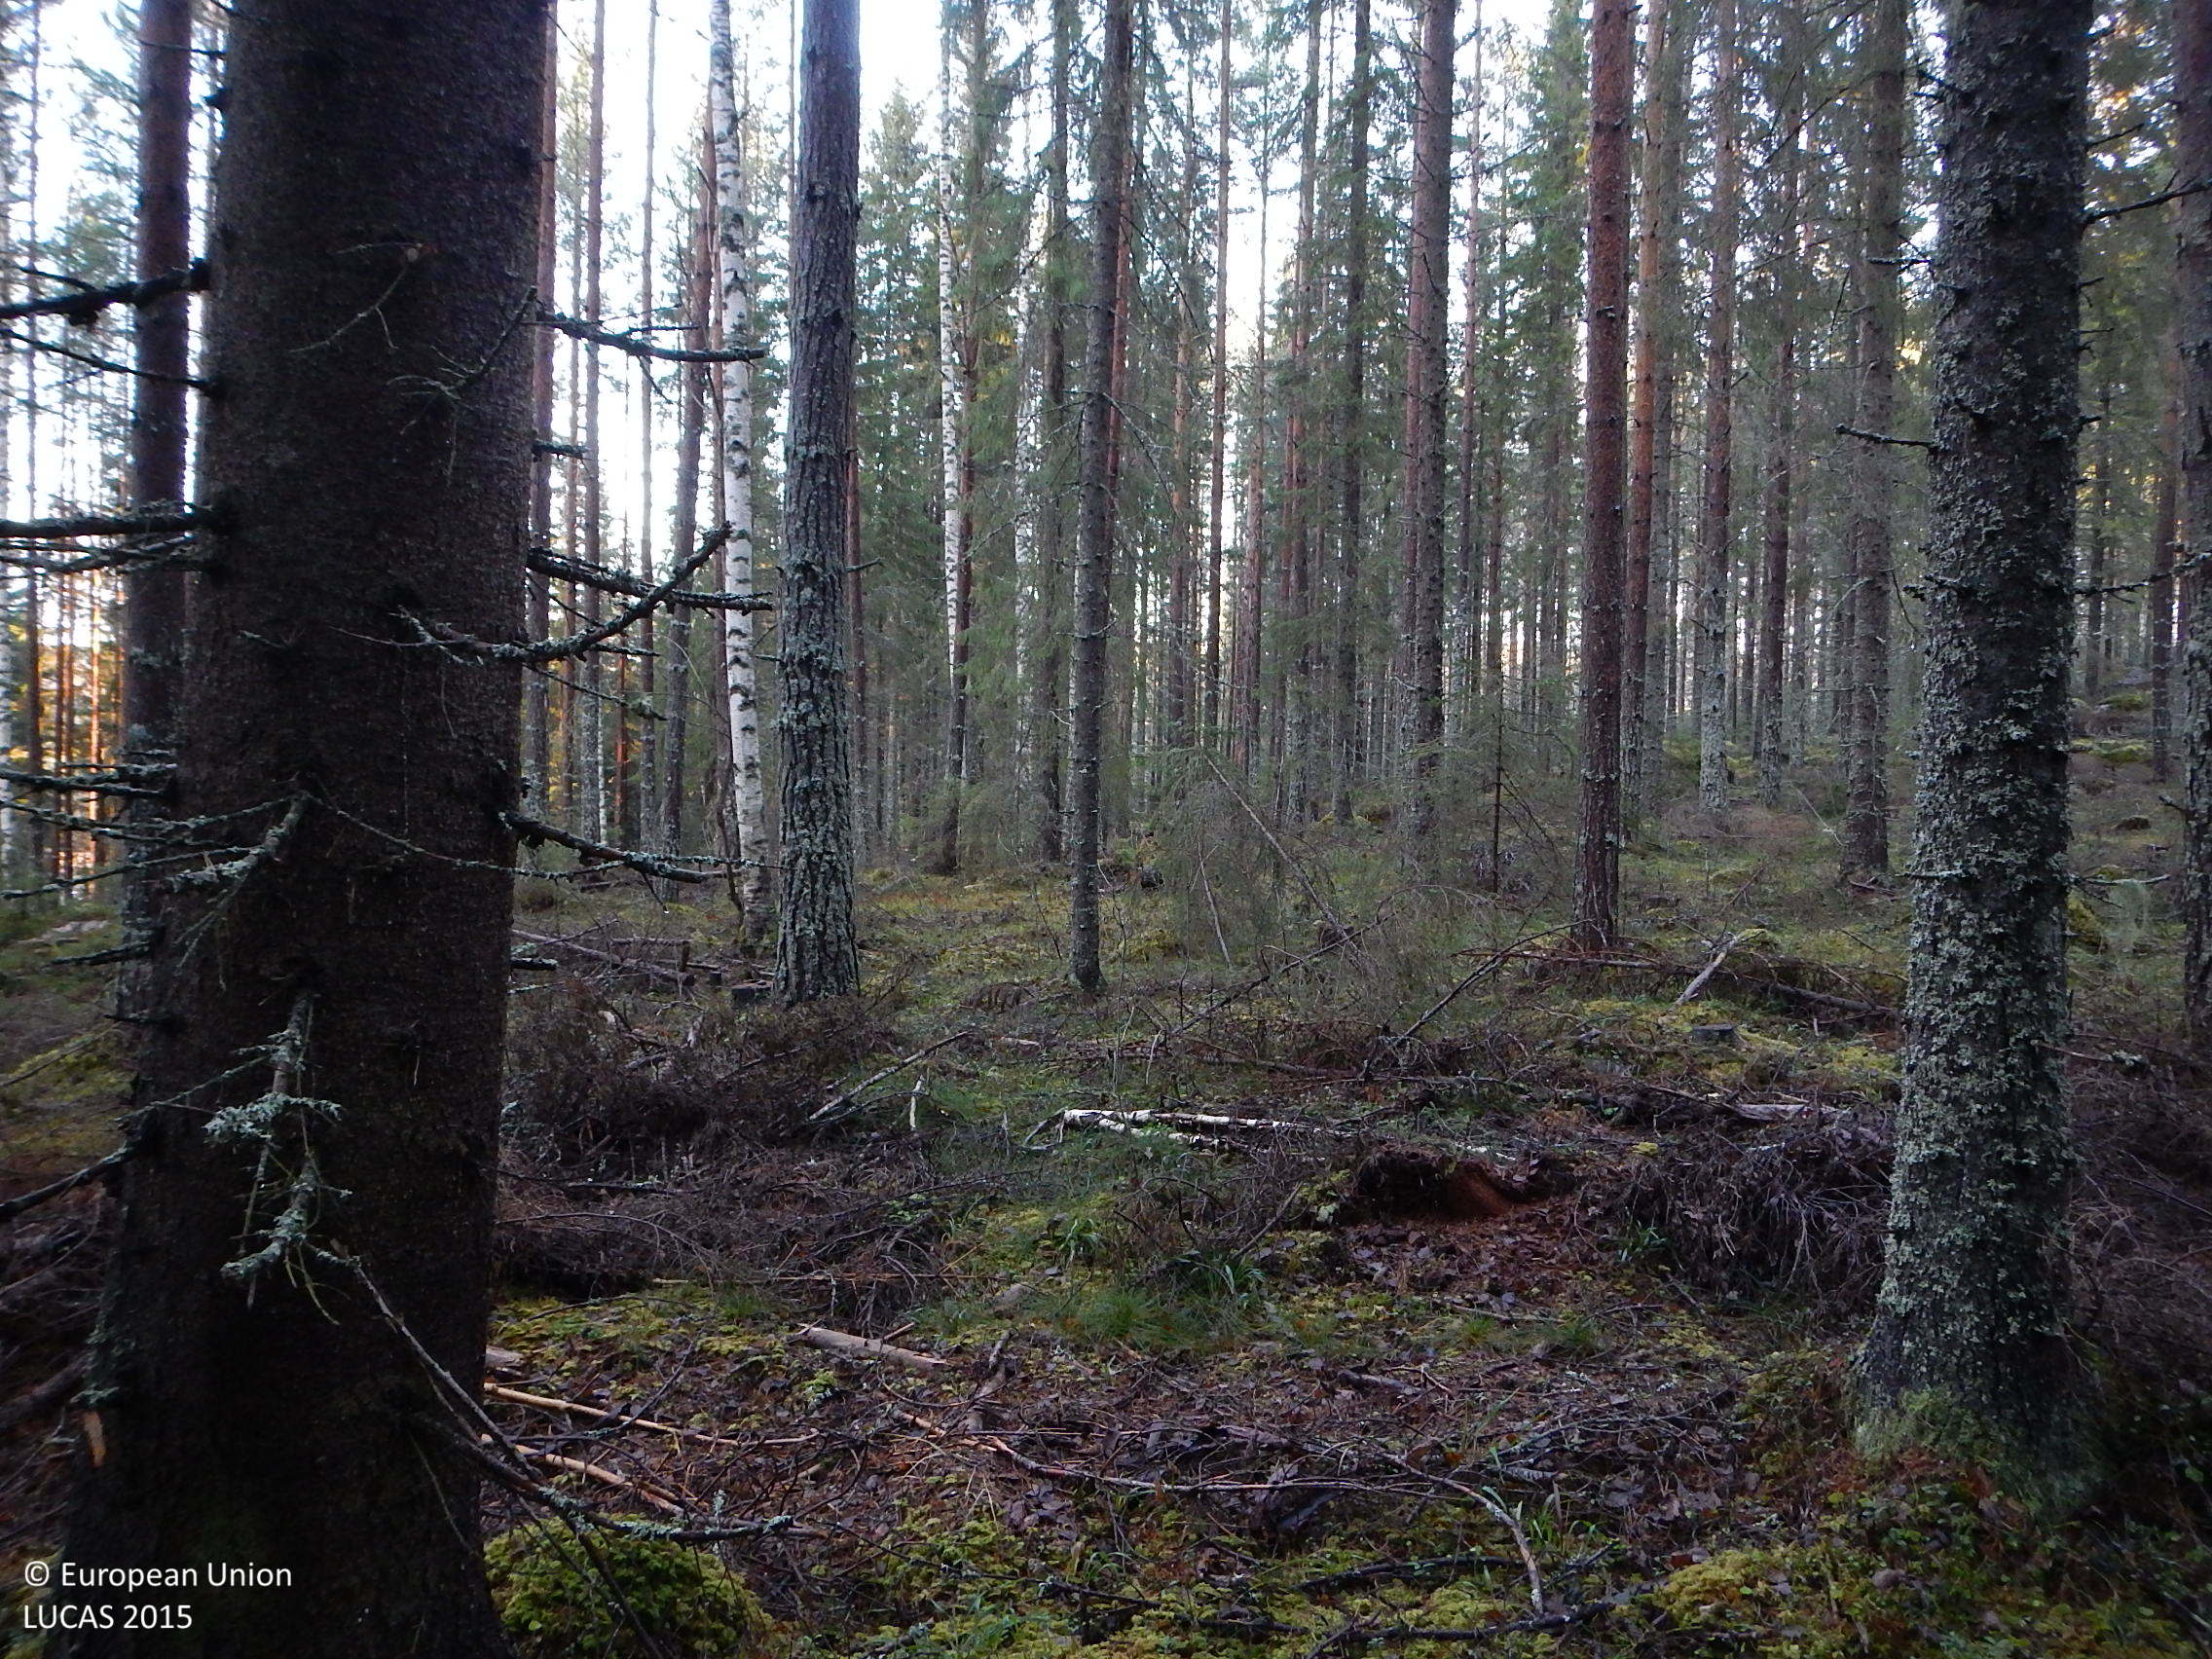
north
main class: Woodland
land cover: Spruce dominated coniferous woodland
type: boreal forest
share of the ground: > 75 %
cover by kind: coniferous forest trees 80 %, lichens and mosses 15 %, broadleaved forest trees 5 %
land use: Forestry
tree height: > 5 m
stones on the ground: < 10 %
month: November
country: SE
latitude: 61.8813
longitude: 16.3539
